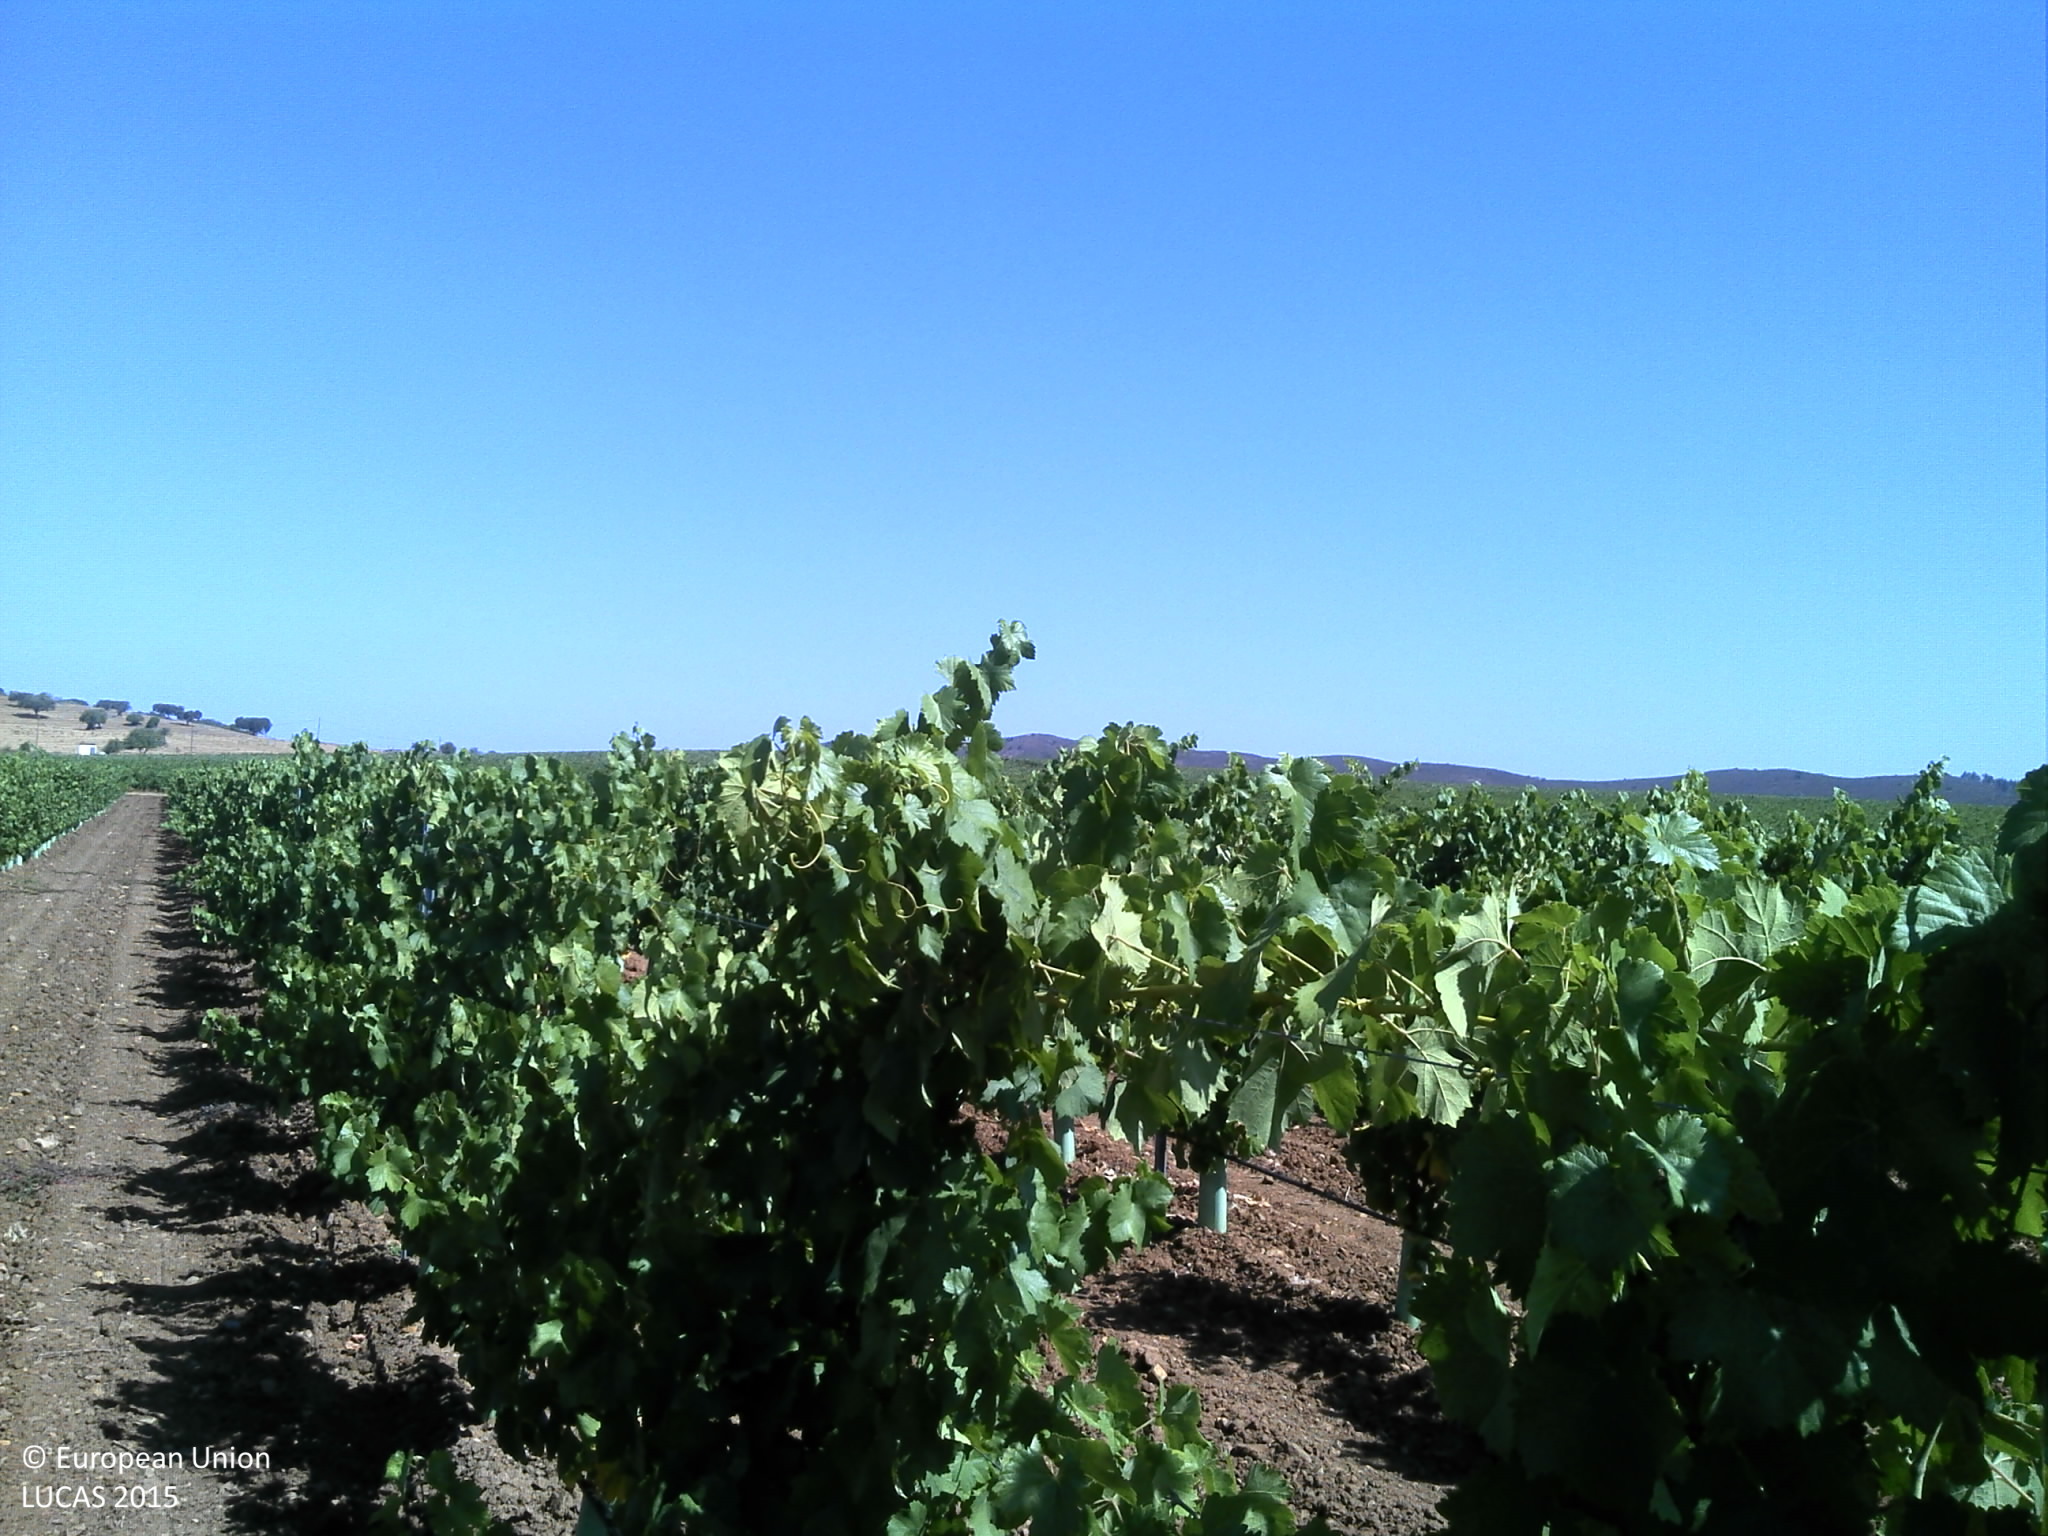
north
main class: Cropland
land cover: Vineyards
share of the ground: 25 - 50 %
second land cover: Other bare soil
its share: > 75 %
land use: Agriculture (excluding fallow land and kitchen gardens)
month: July
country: PT
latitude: 38.4530
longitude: -7.4323
